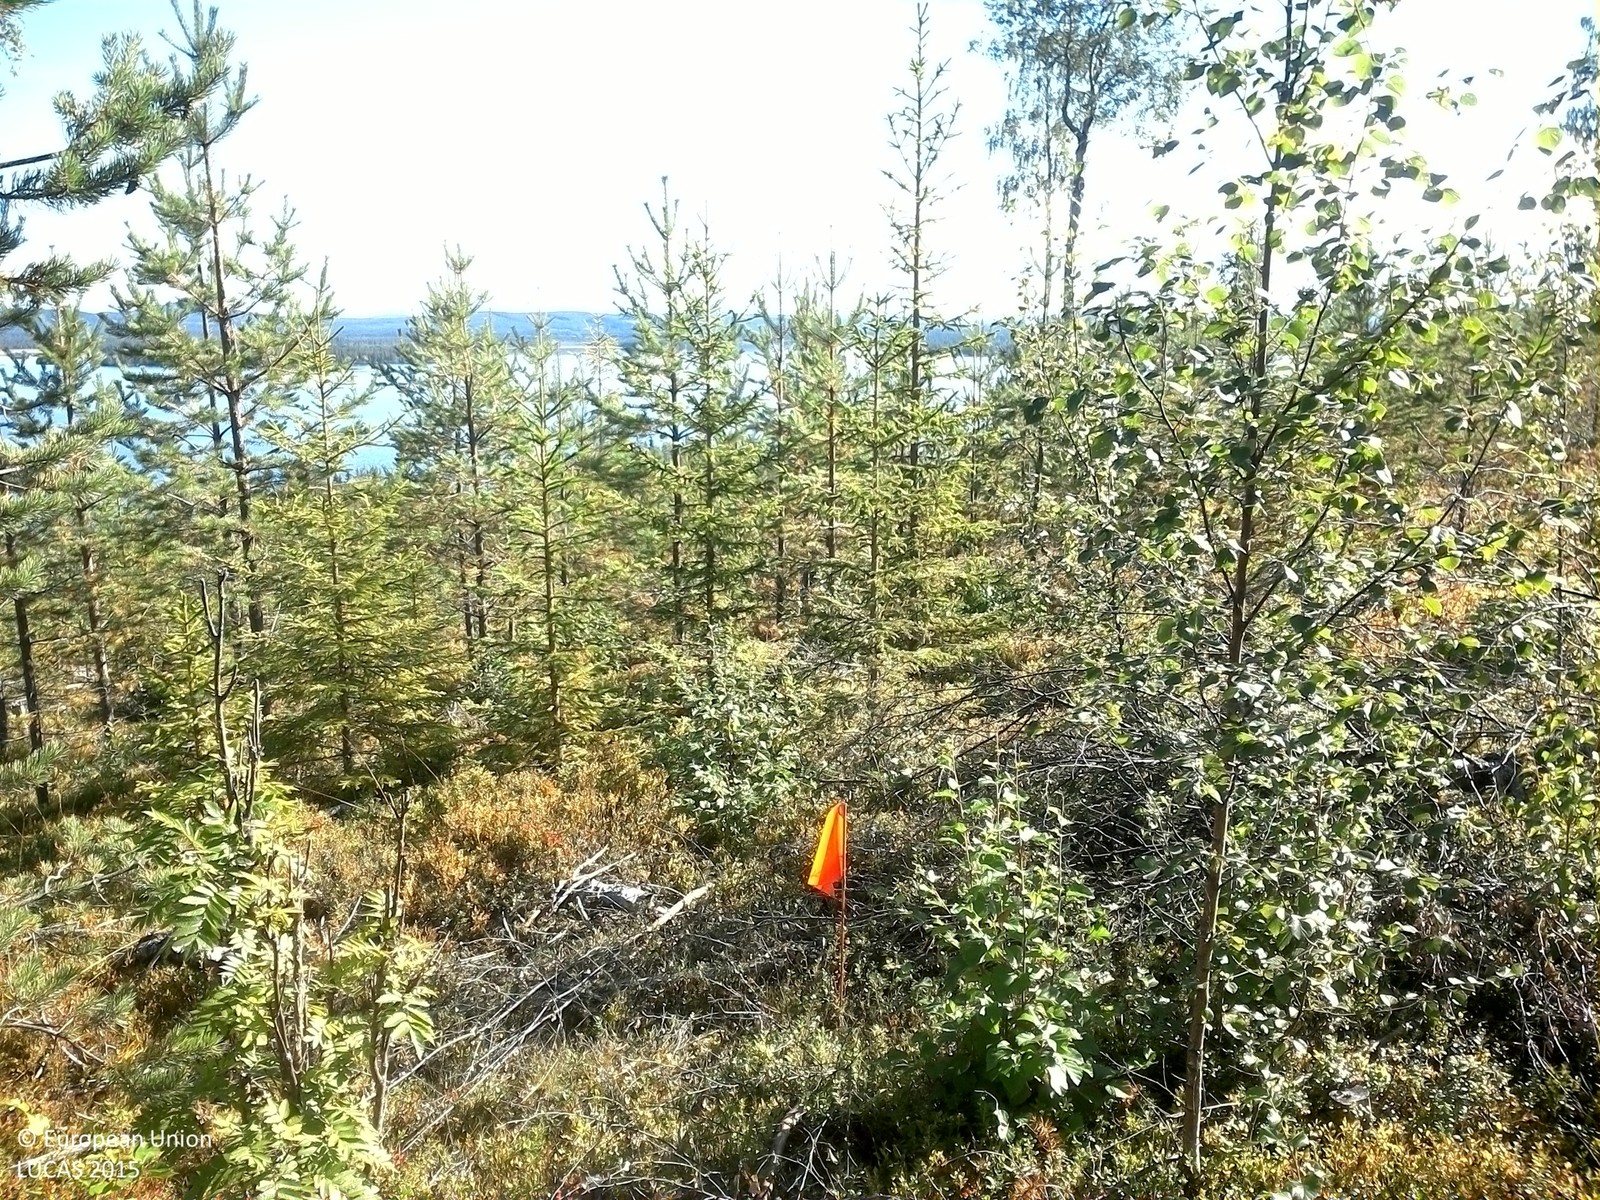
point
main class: Woodland
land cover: Pine dominated mixed woodland
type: boreal forest
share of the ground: 50 - 75 %
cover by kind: coniferous forest trees 40 %, shrubs 25 %, broadleaved forest trees 20 %, lichens and mosses 10 %, herbaceous plants 5 %
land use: Forestry
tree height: < 5 m
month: August
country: SE
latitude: 63.9277
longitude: 17.1698
